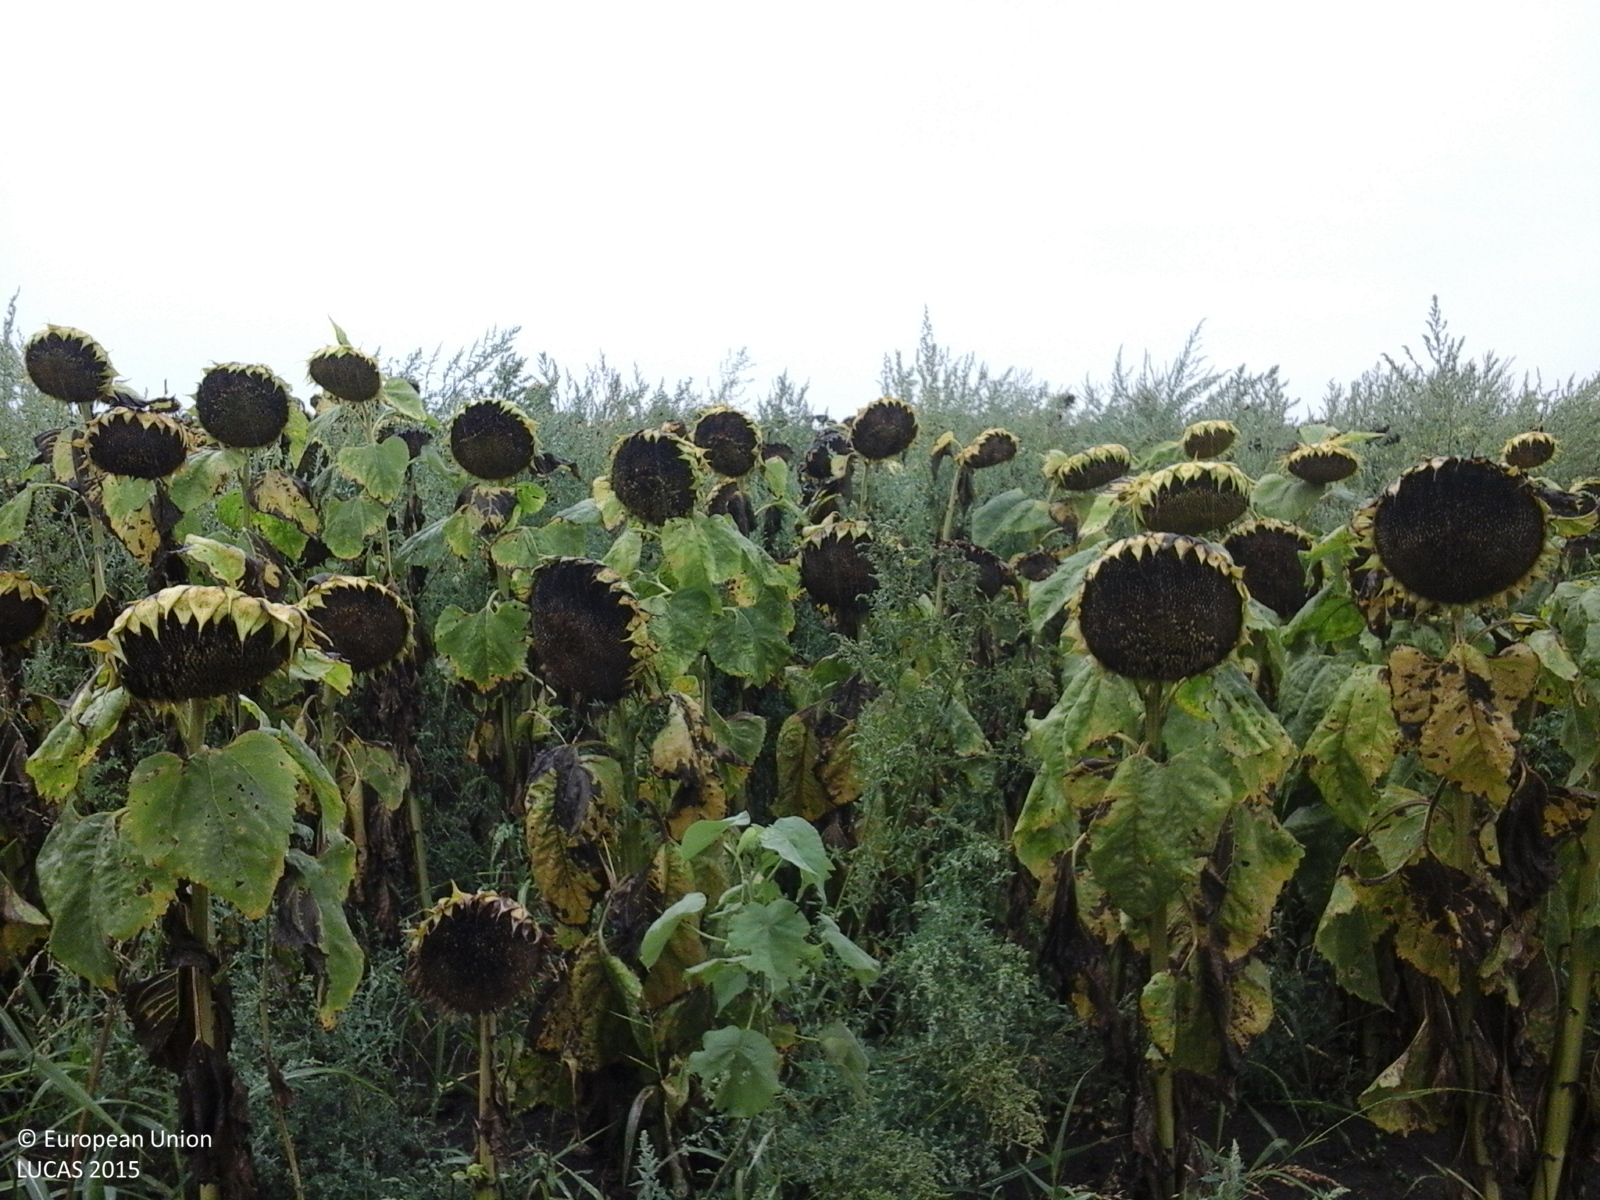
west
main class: Cropland
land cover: Sunflower
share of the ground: > 75 %
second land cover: Spontaneously vegetated surfaces
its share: 25 - 50 %
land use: Agriculture (excluding fallow land and kitchen gardens)
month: August
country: RO
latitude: 45.5864
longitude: 20.9598
